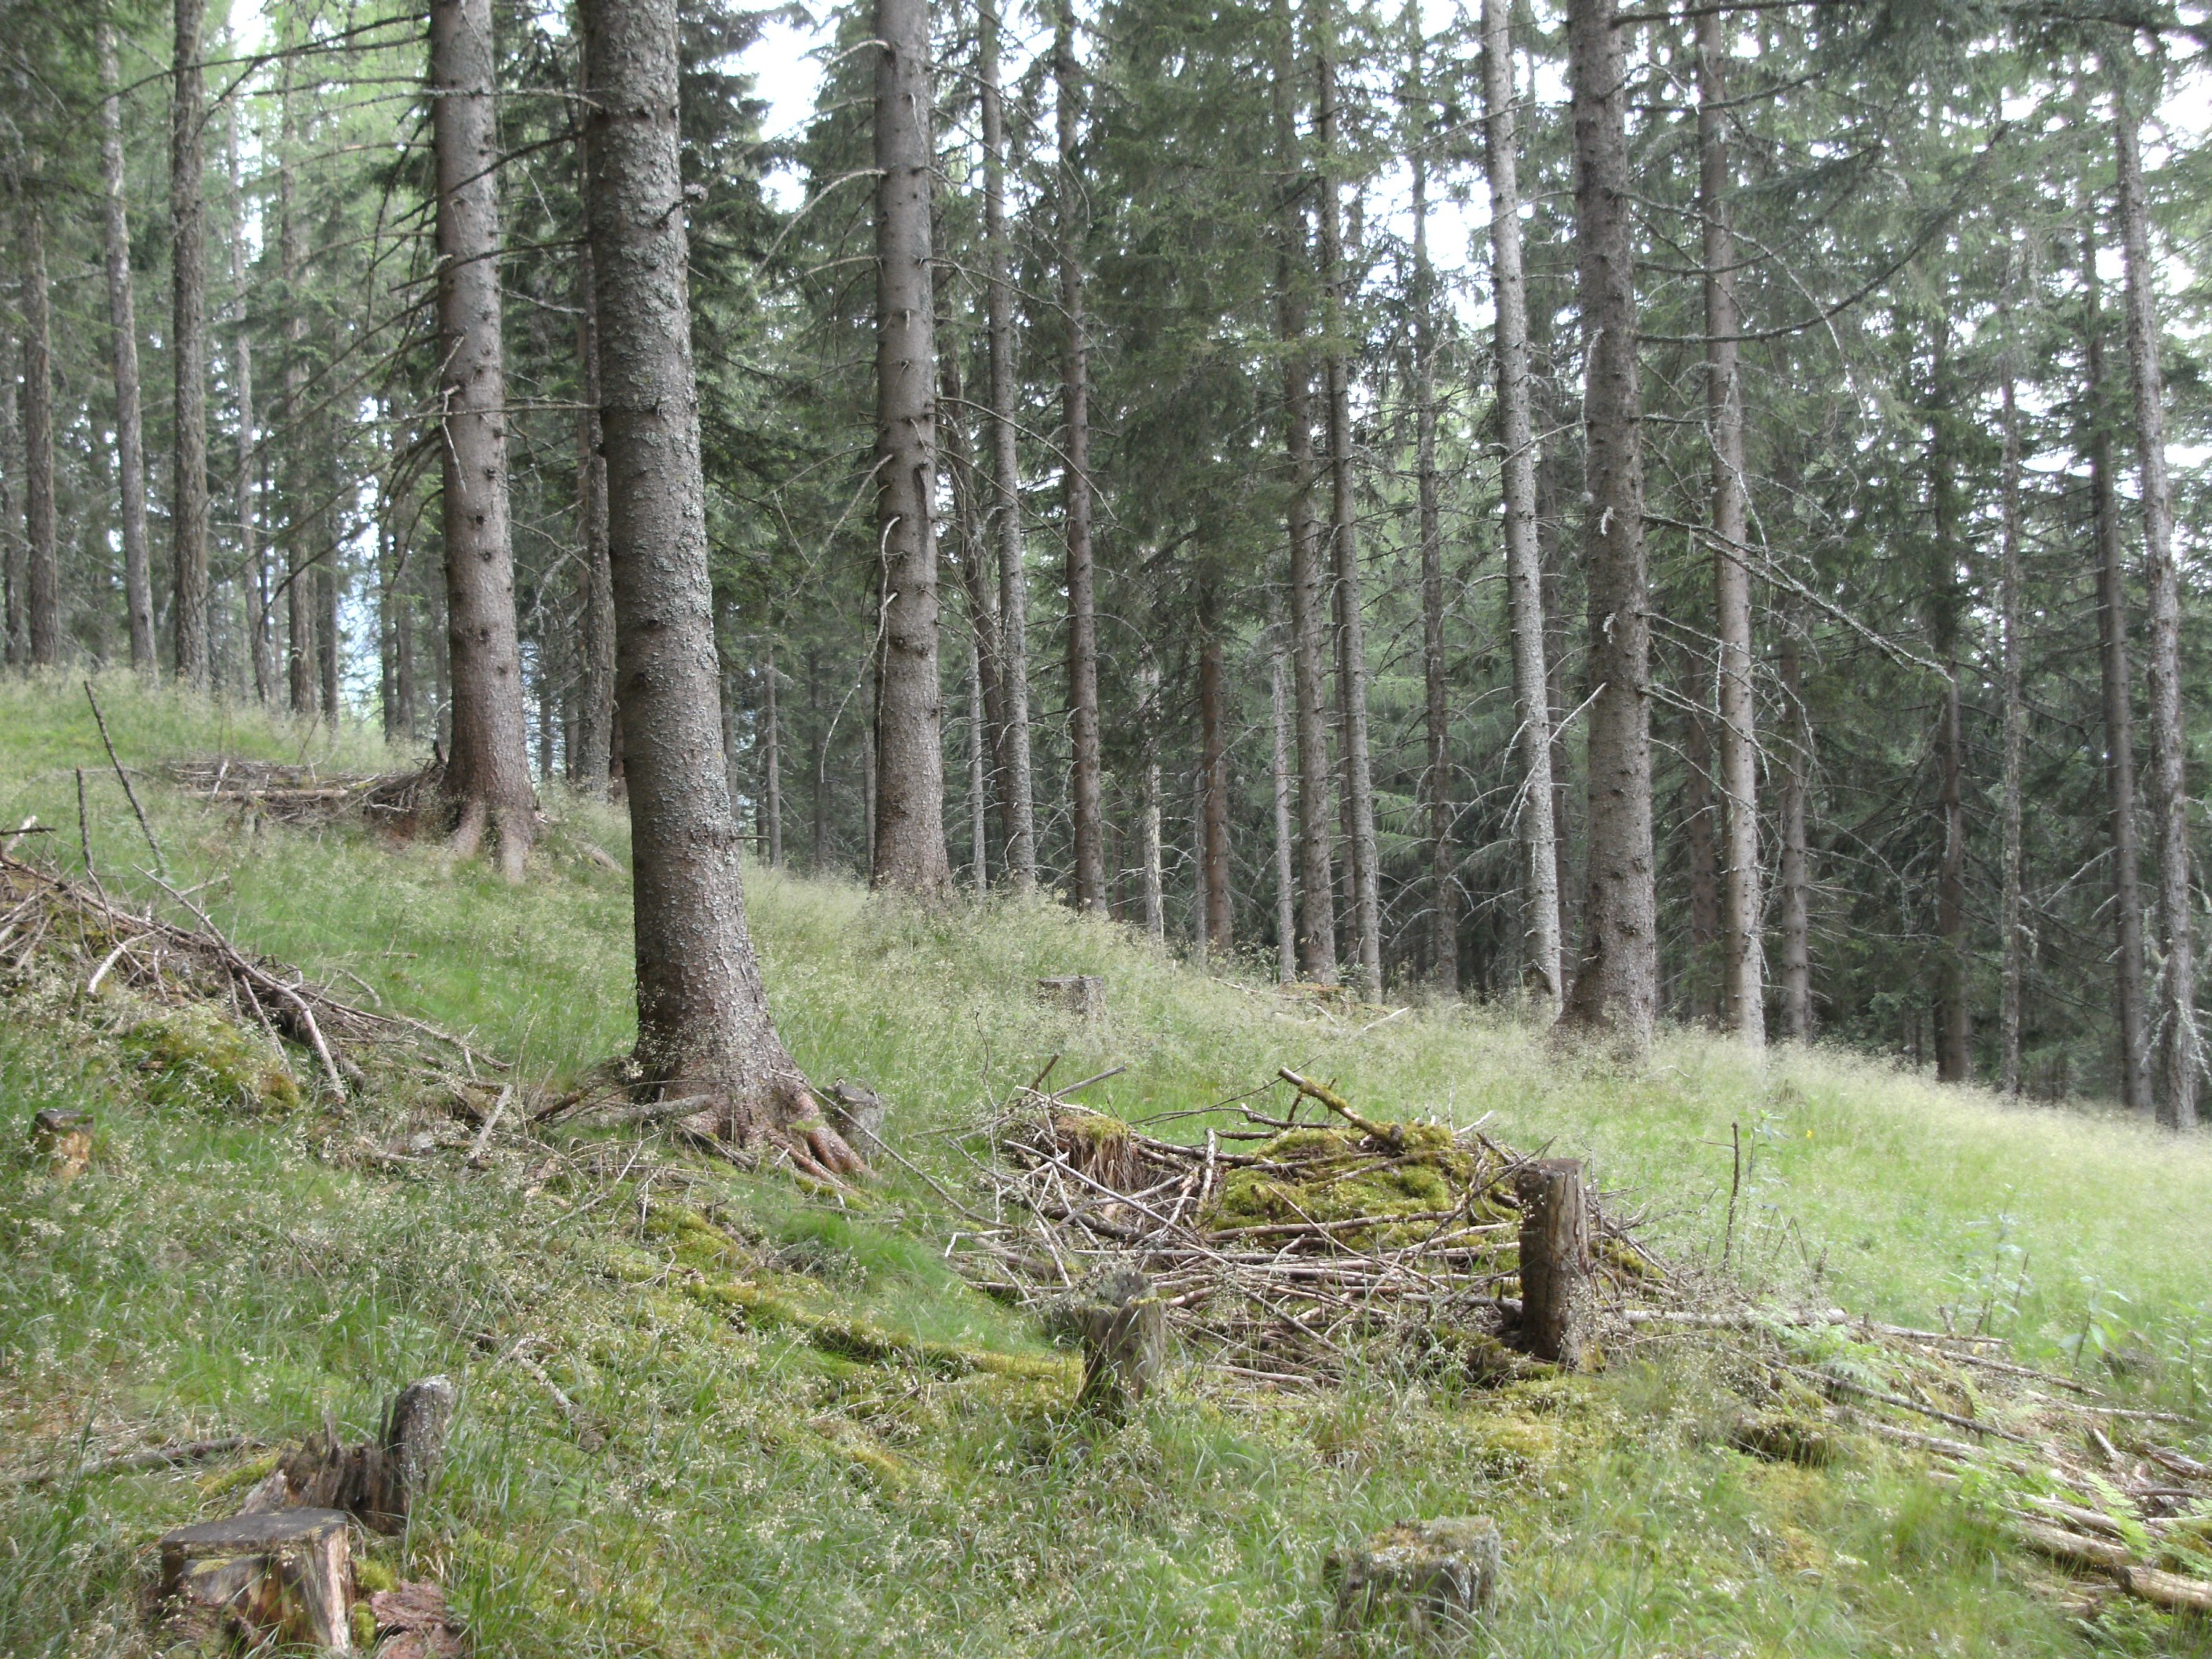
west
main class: Woodland
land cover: Other coniferous woodland
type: alpine coniferous forest
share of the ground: 50 - 75 %
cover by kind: coniferous forest trees 75 %, shrubs 20 %, unconsolidated bare surface 5 %
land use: Forestry
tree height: > 5 m
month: July
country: AT
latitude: 46.9676
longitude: 14.7432
